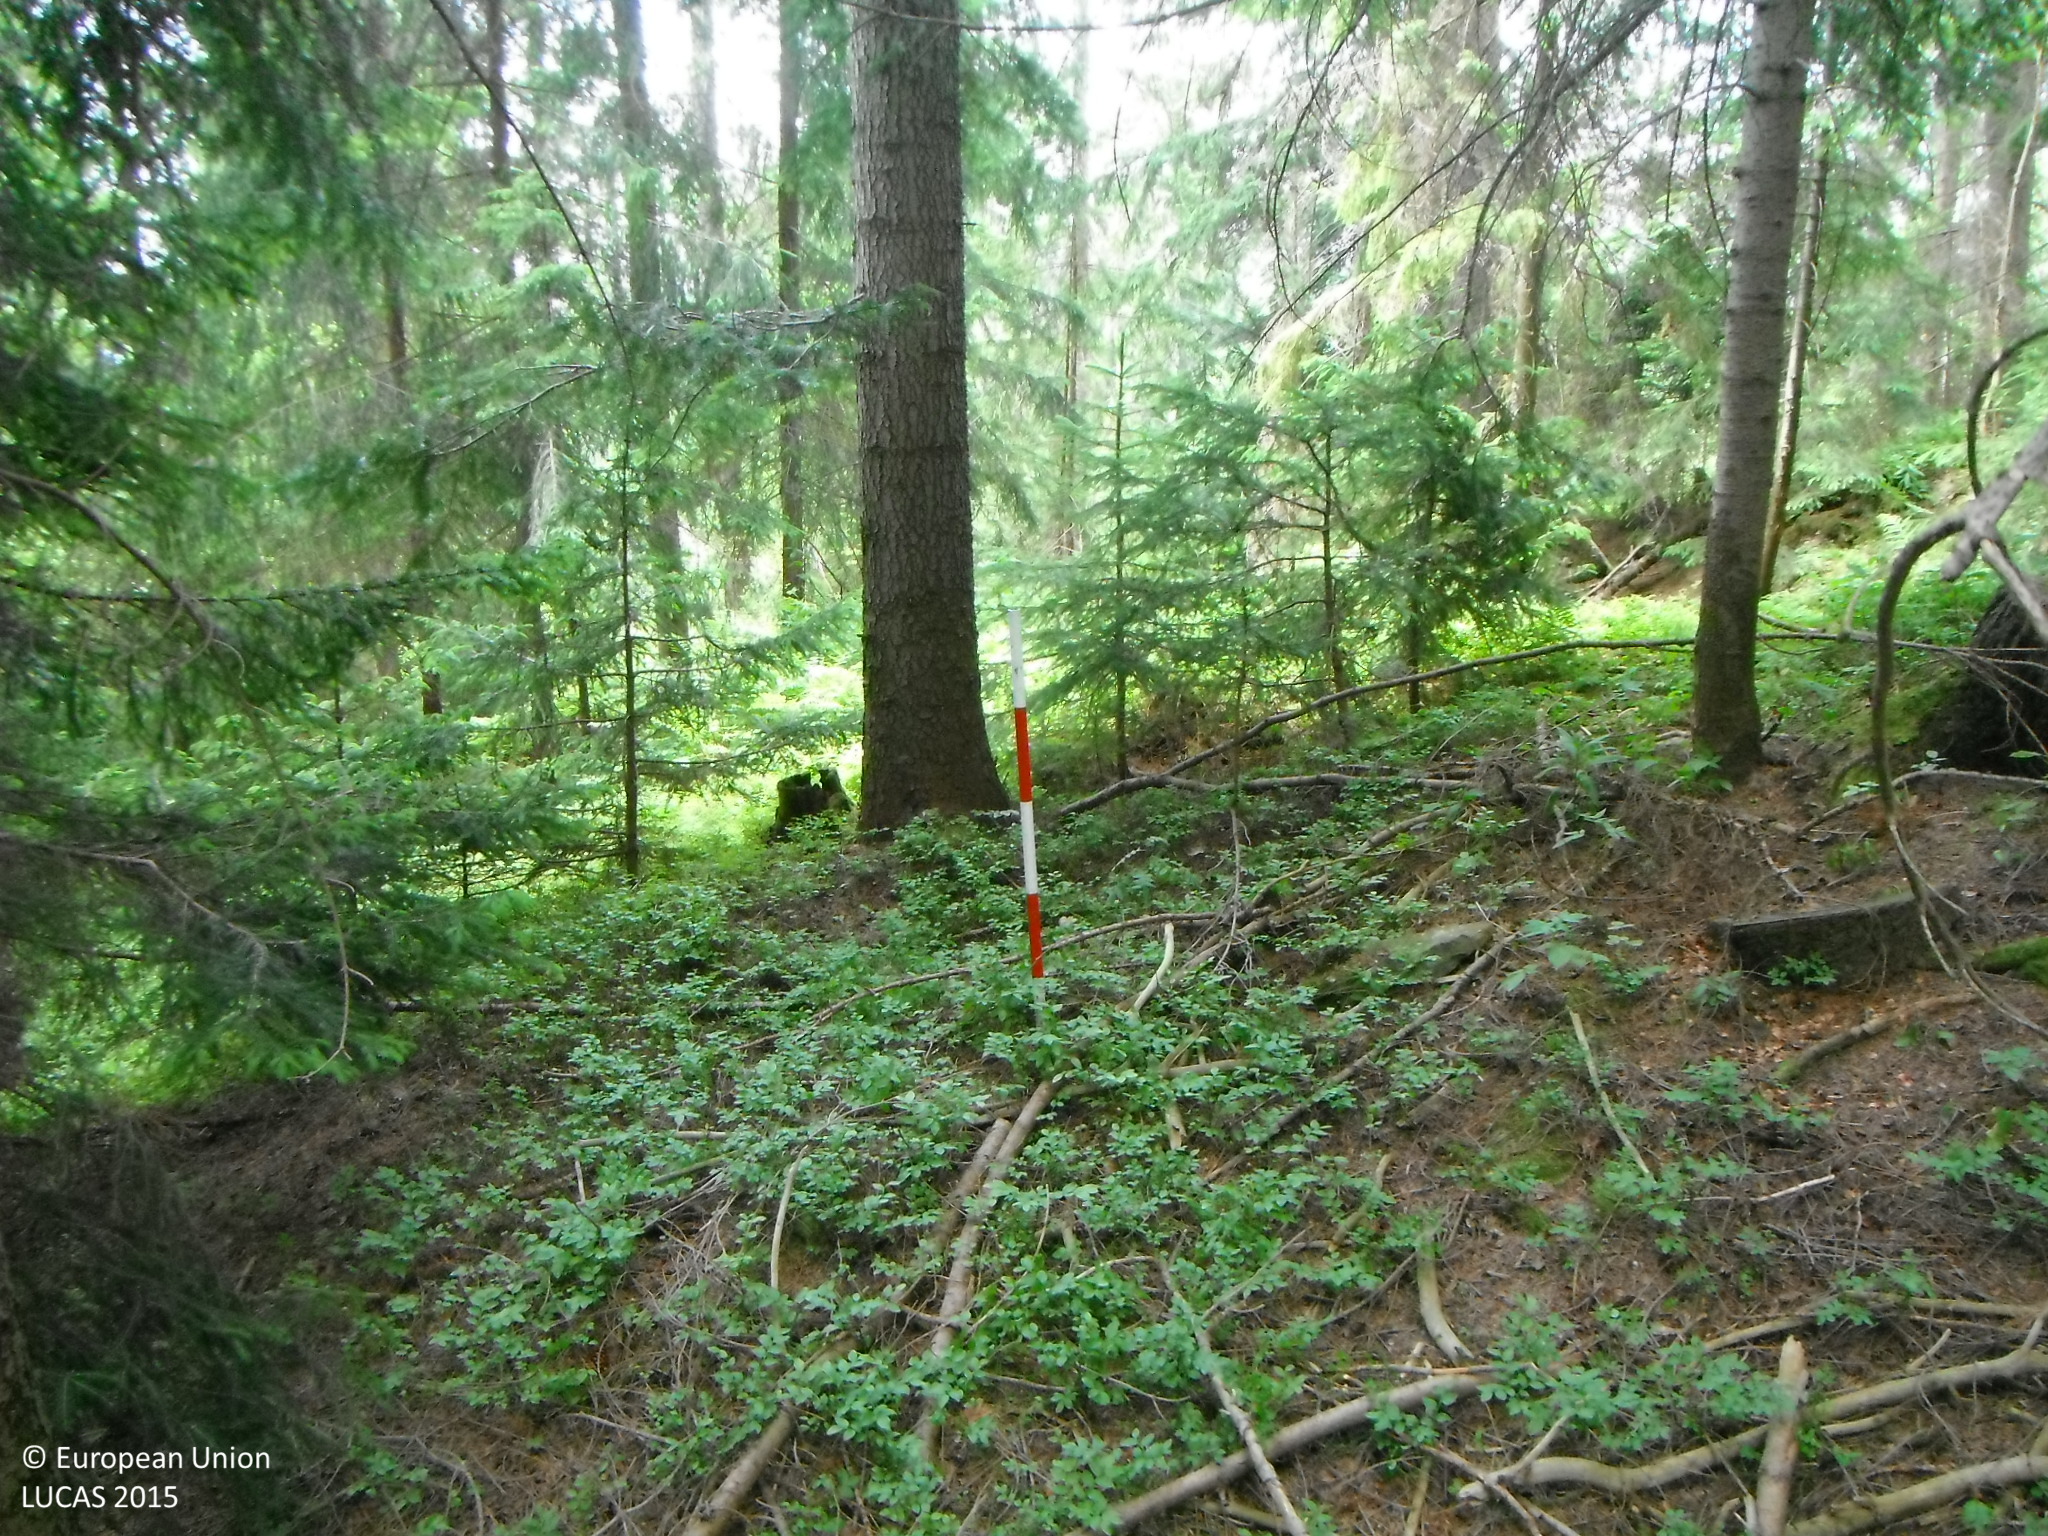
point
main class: Woodland
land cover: Spruce dominated coniferous woodland
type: alpine coniferous forest
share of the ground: > 75 %
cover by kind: coniferous forest trees 95 %, herbaceous plants 5 %
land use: Forestry
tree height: > 5 m
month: July
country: SK
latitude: 49.5115
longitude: 19.5430
